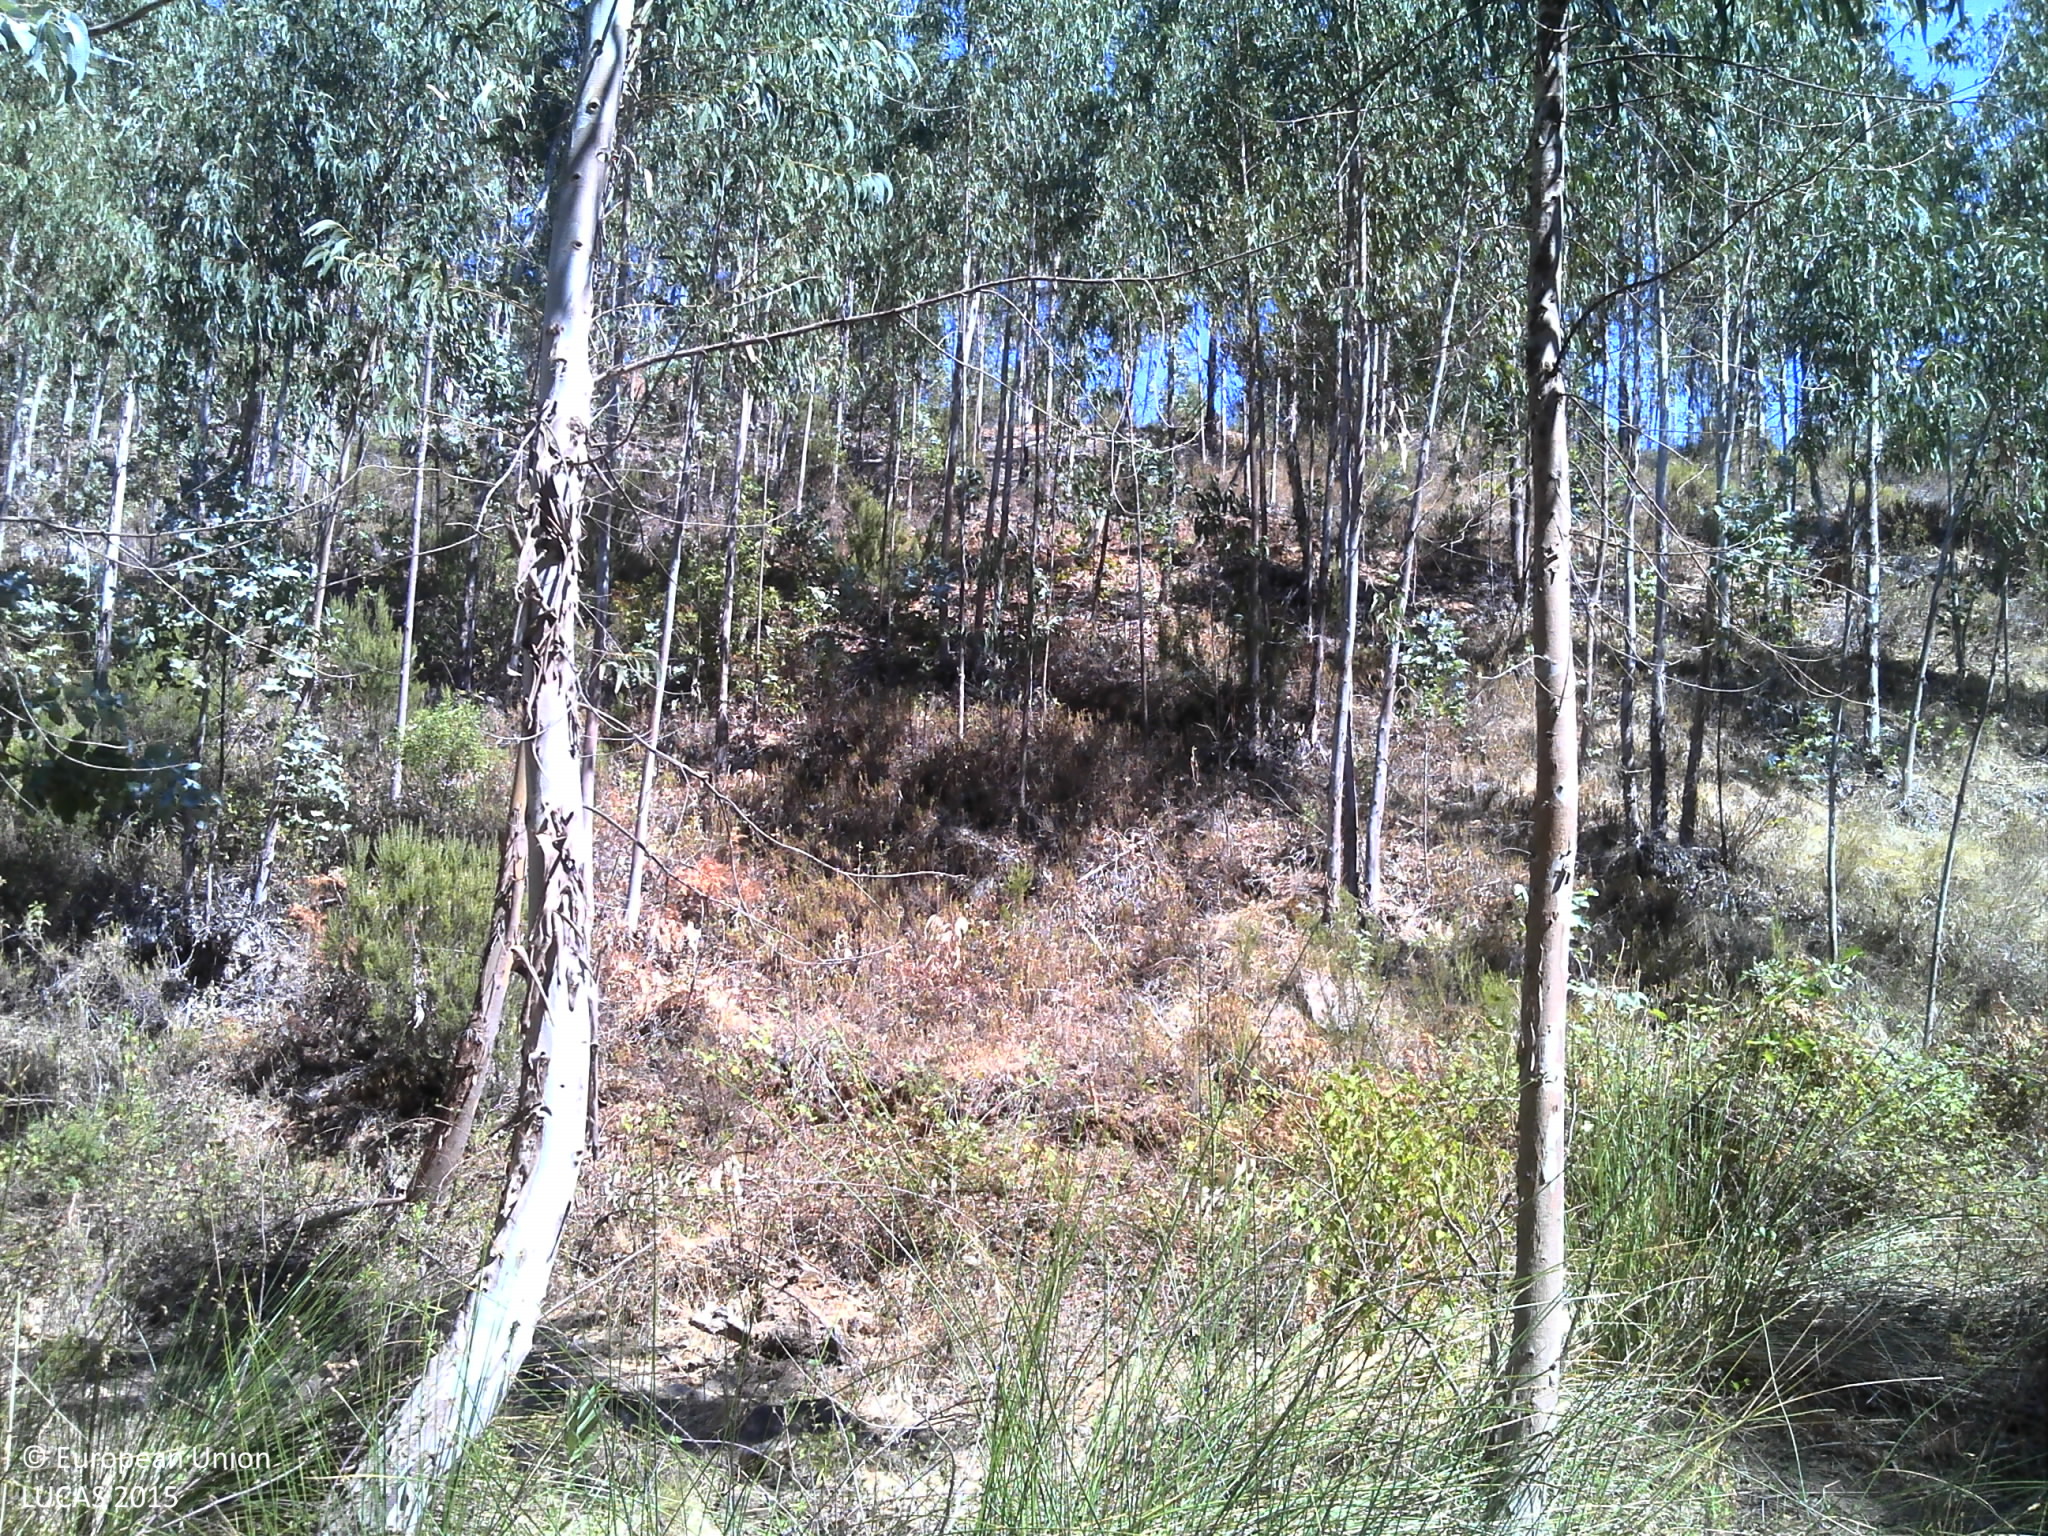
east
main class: Woodland
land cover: Broadleaved woodland
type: exotic forest
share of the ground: 50 - 75 %
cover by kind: broadleaved forest trees 70 %, unconsolidated bare surface 20 %, shrubs 10 %
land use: Forestry
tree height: > 5 m
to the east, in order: Broadleaved woodland; Rivers and streams; Broadleaved woodland; Other structural elements; Broadleaved woodland; Tracks; Grassland without tree/shrub cover; Tracks; Shrubland without tree cover; Rivers and streams; Broadleaved woodland
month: September
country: PT
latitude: 37.3541
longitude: -8.4411
